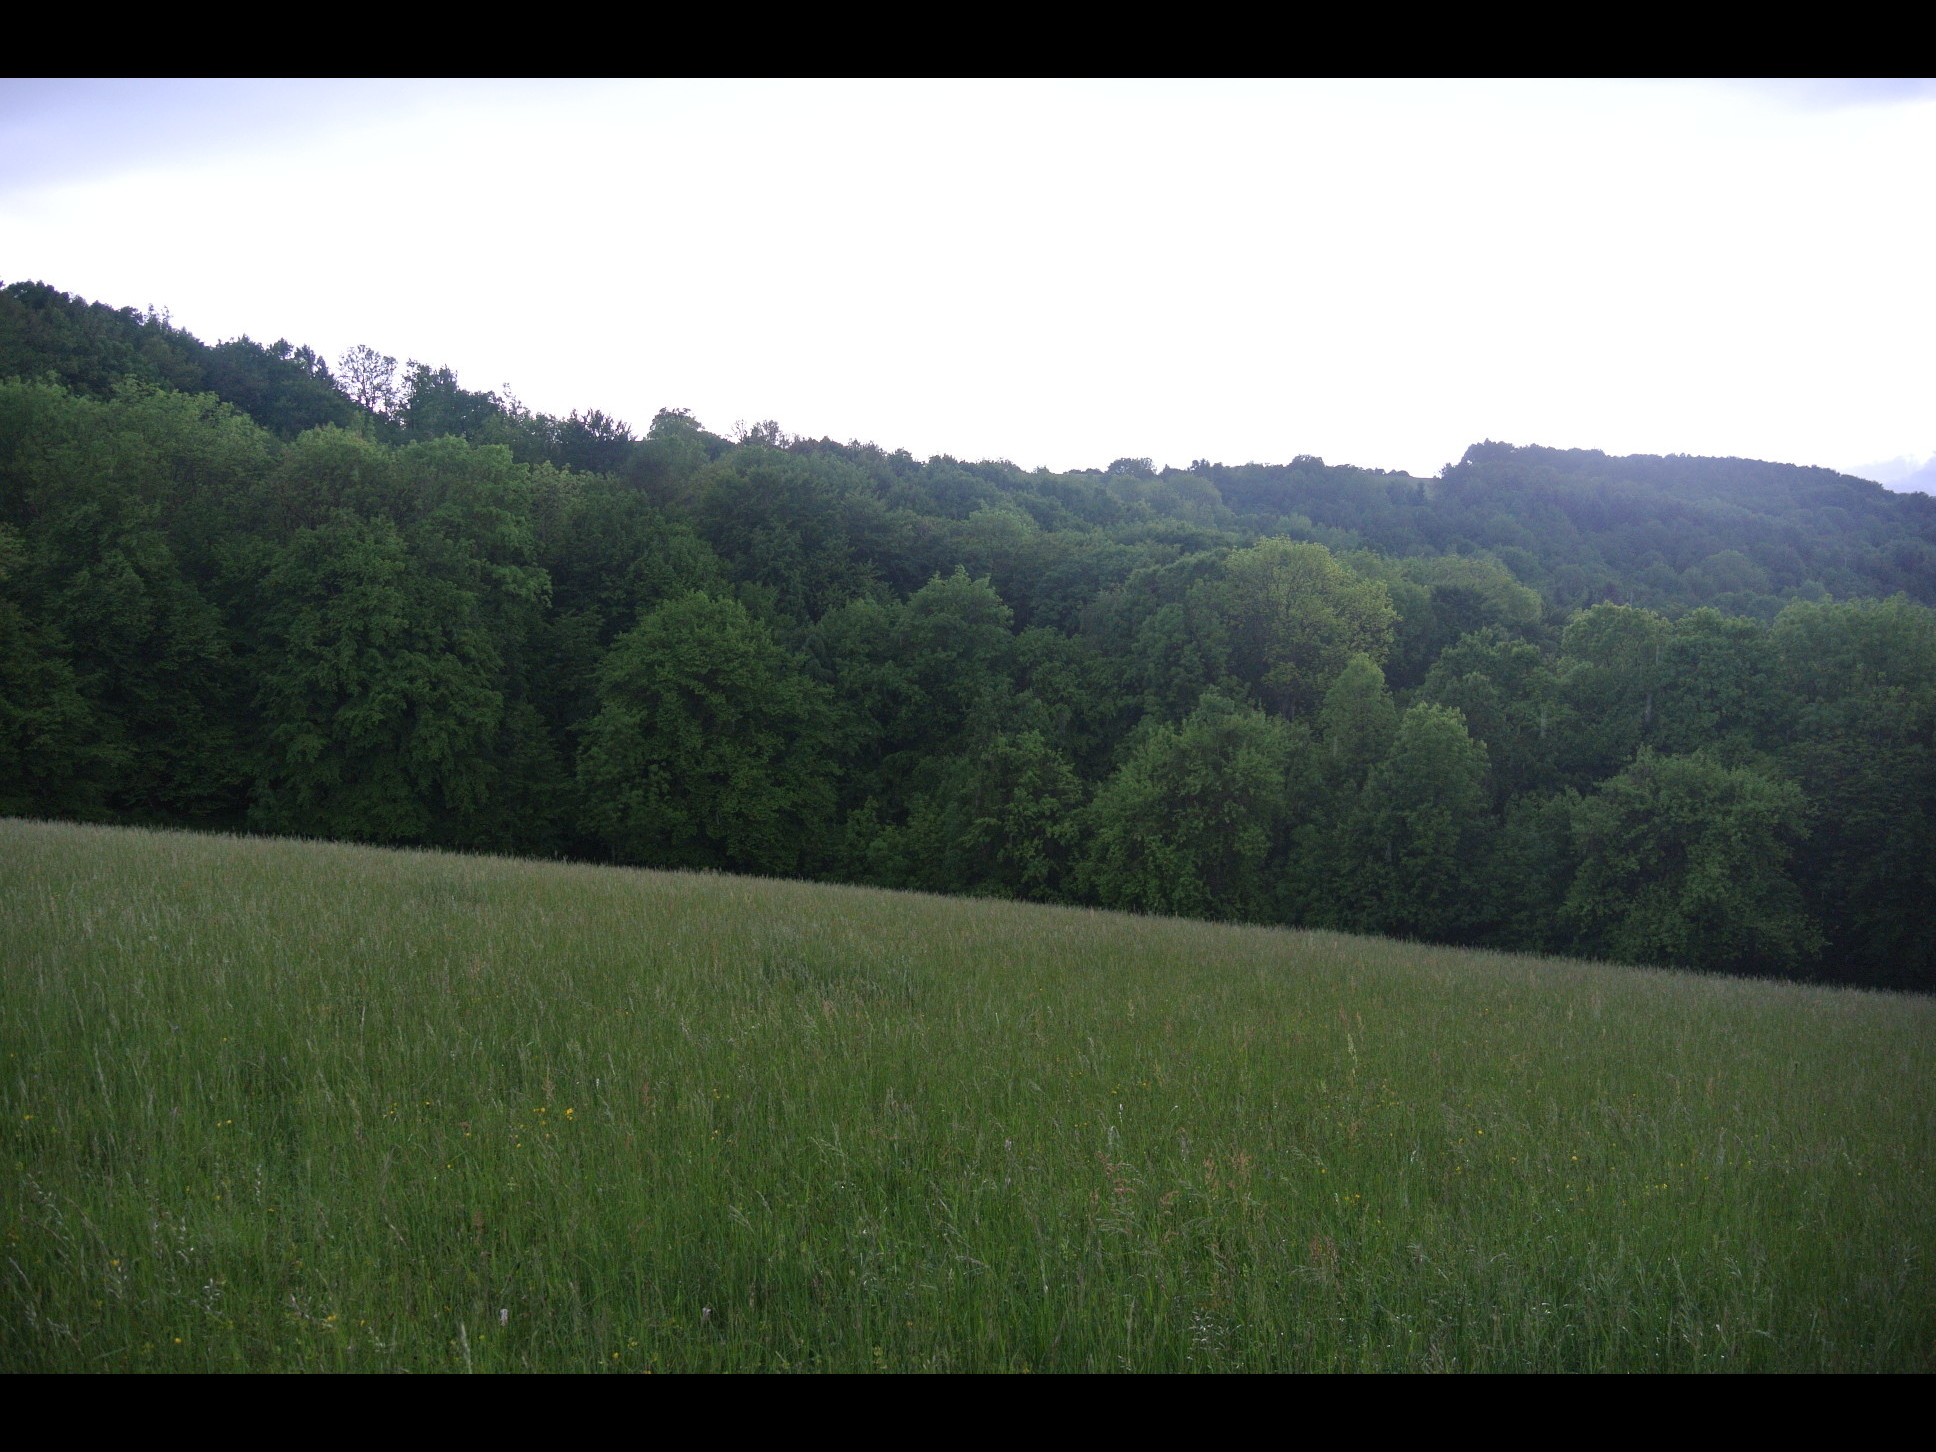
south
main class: Grassland
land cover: Grassland without tree/shrub cover
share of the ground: > 75 %
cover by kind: herbaceous plants 100 %
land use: Agriculture (excluding fallow land and kitchen gardens)
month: May
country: AT
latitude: 48.1225
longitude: 15.8470
